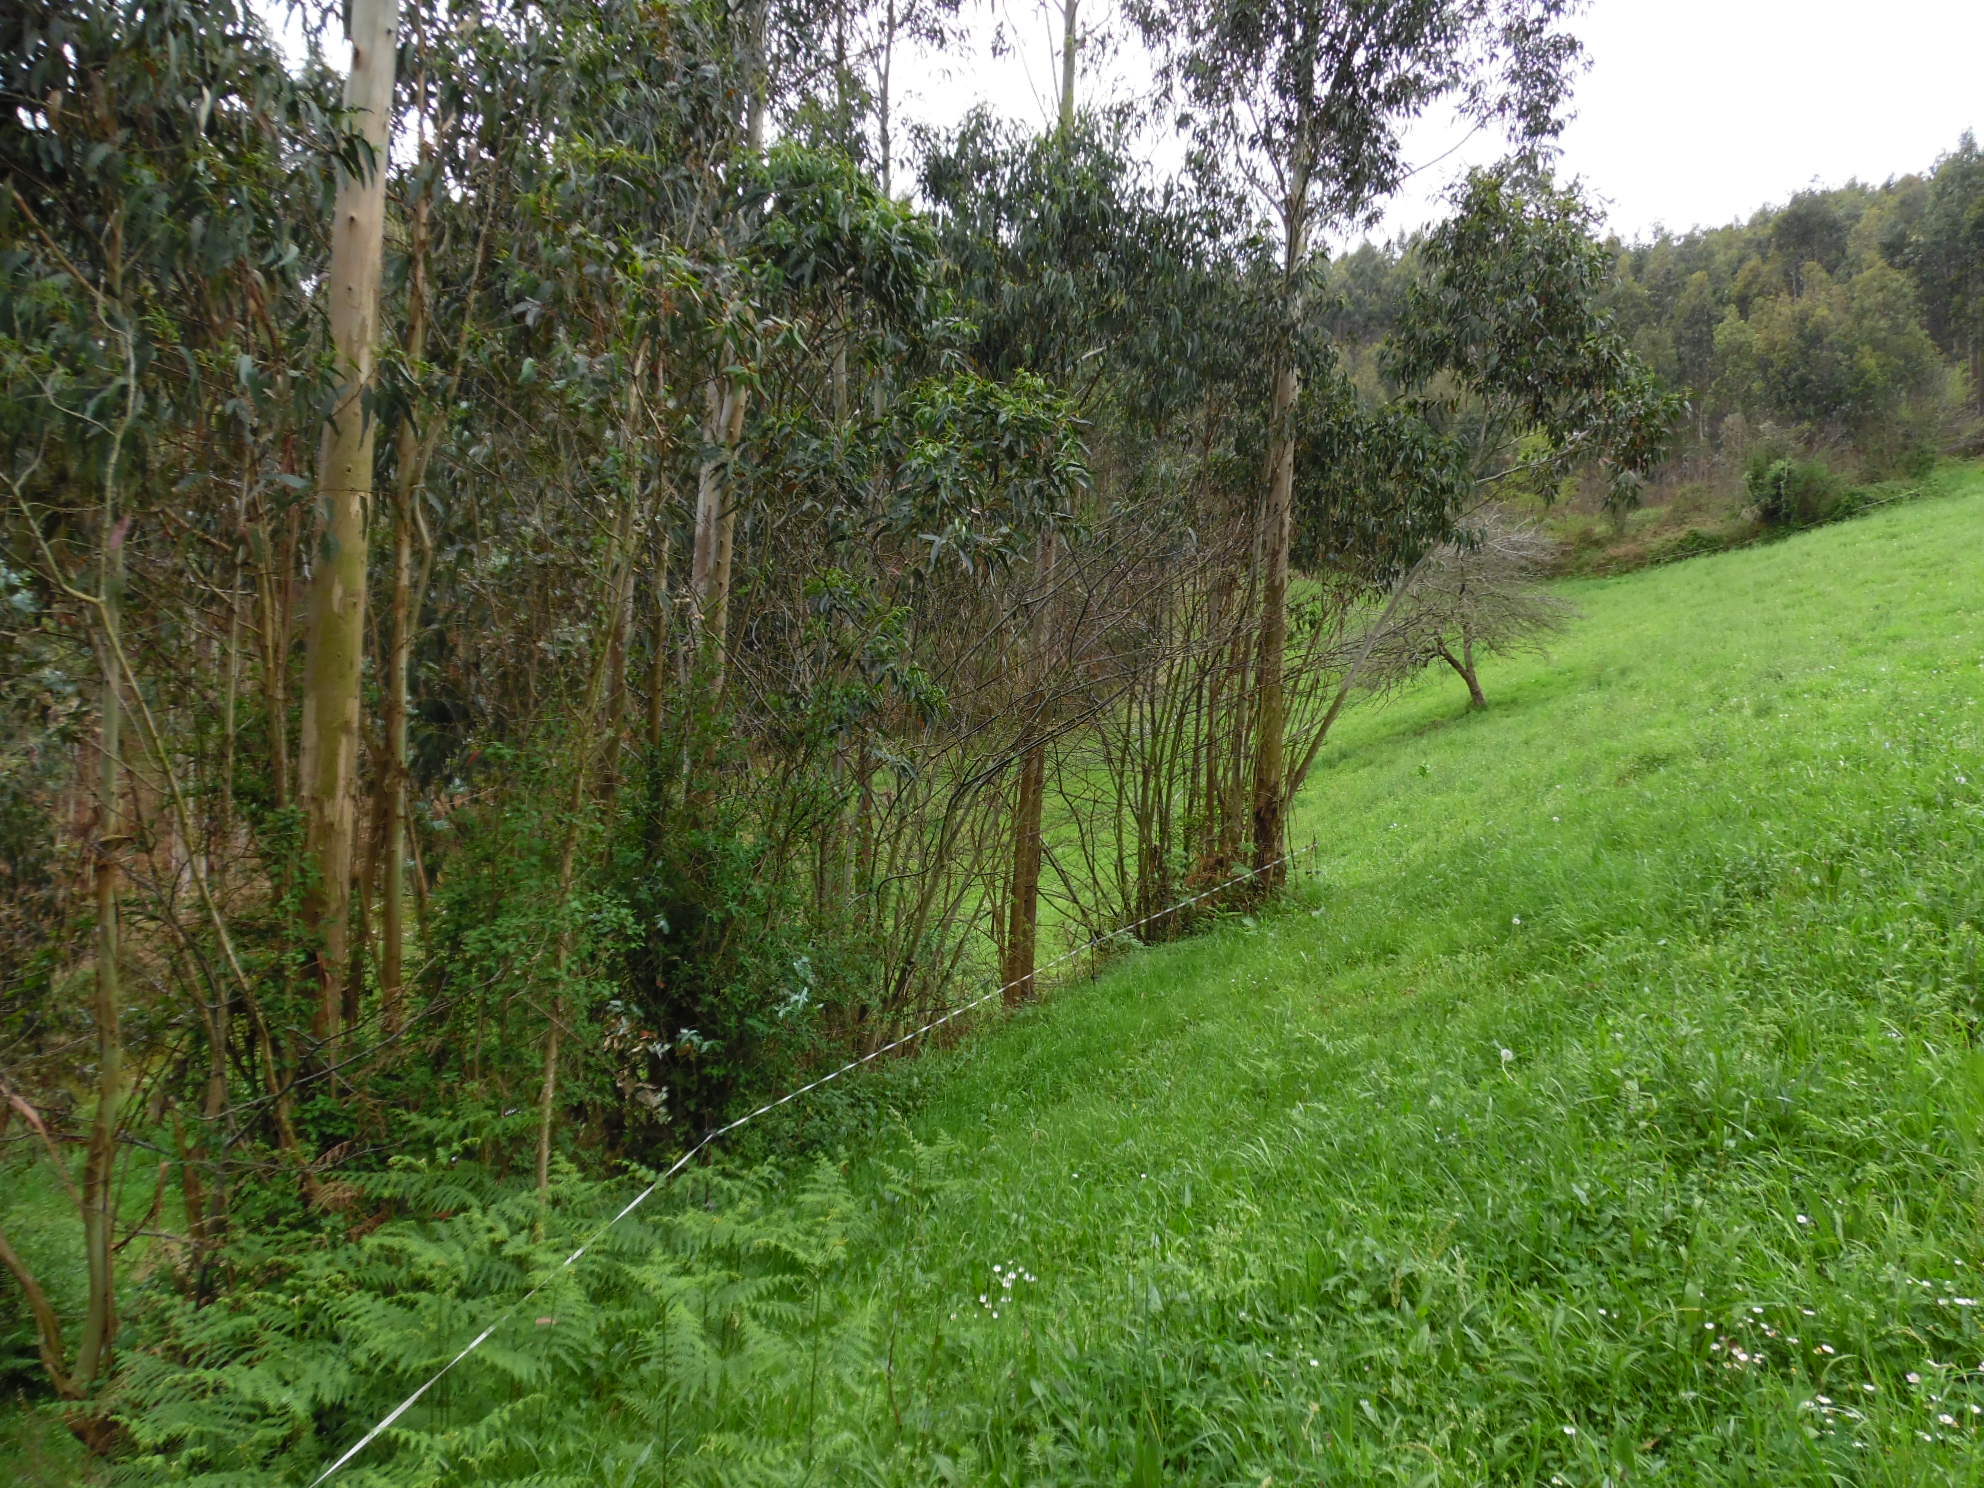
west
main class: Grassland
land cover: Grassland without tree/shrub cover
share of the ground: > 75 %
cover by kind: herbaceous plants 100 %
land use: Agriculture (excluding fallow land and kitchen gardens)
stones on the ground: 10 - 25 %
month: April
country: ES
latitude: 43.5031
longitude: -5.8842
